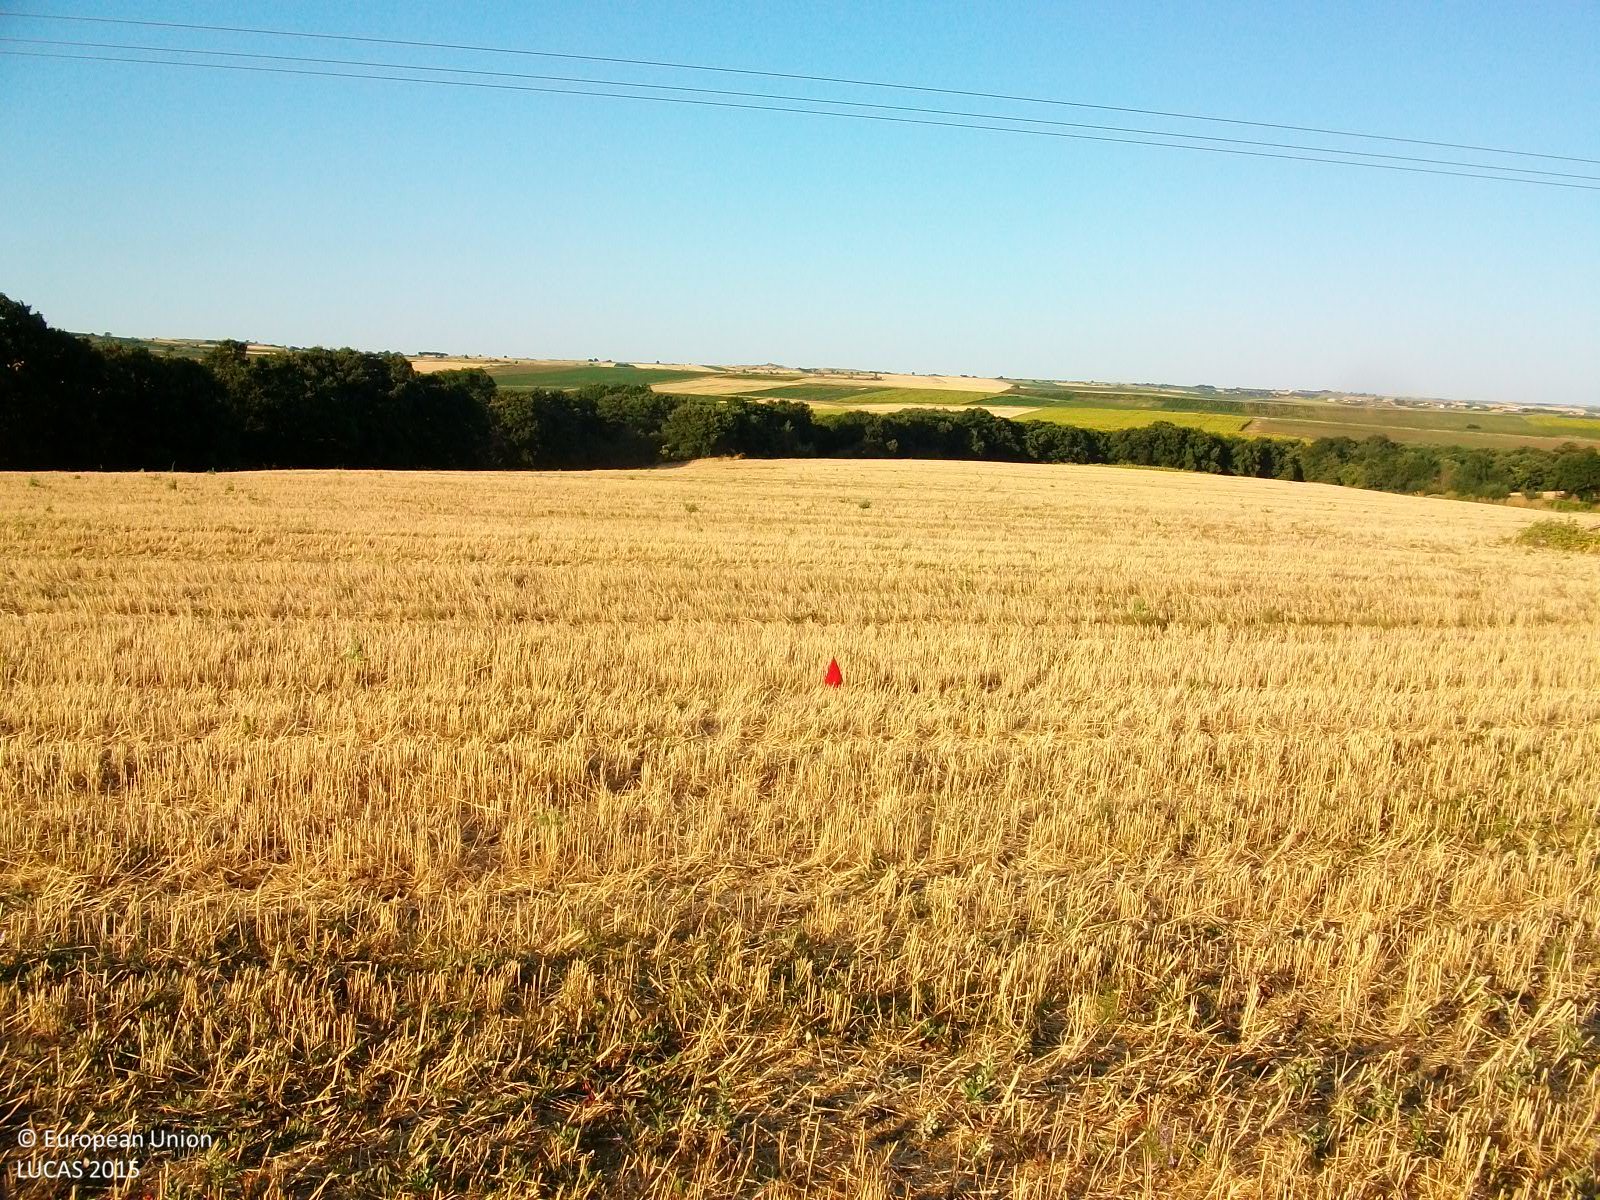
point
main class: Cropland
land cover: Common wheat
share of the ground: > 75 %
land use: Agriculture (excluding fallow land and kitchen gardens)
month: July
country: GR
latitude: 41.4822
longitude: 26.2283
